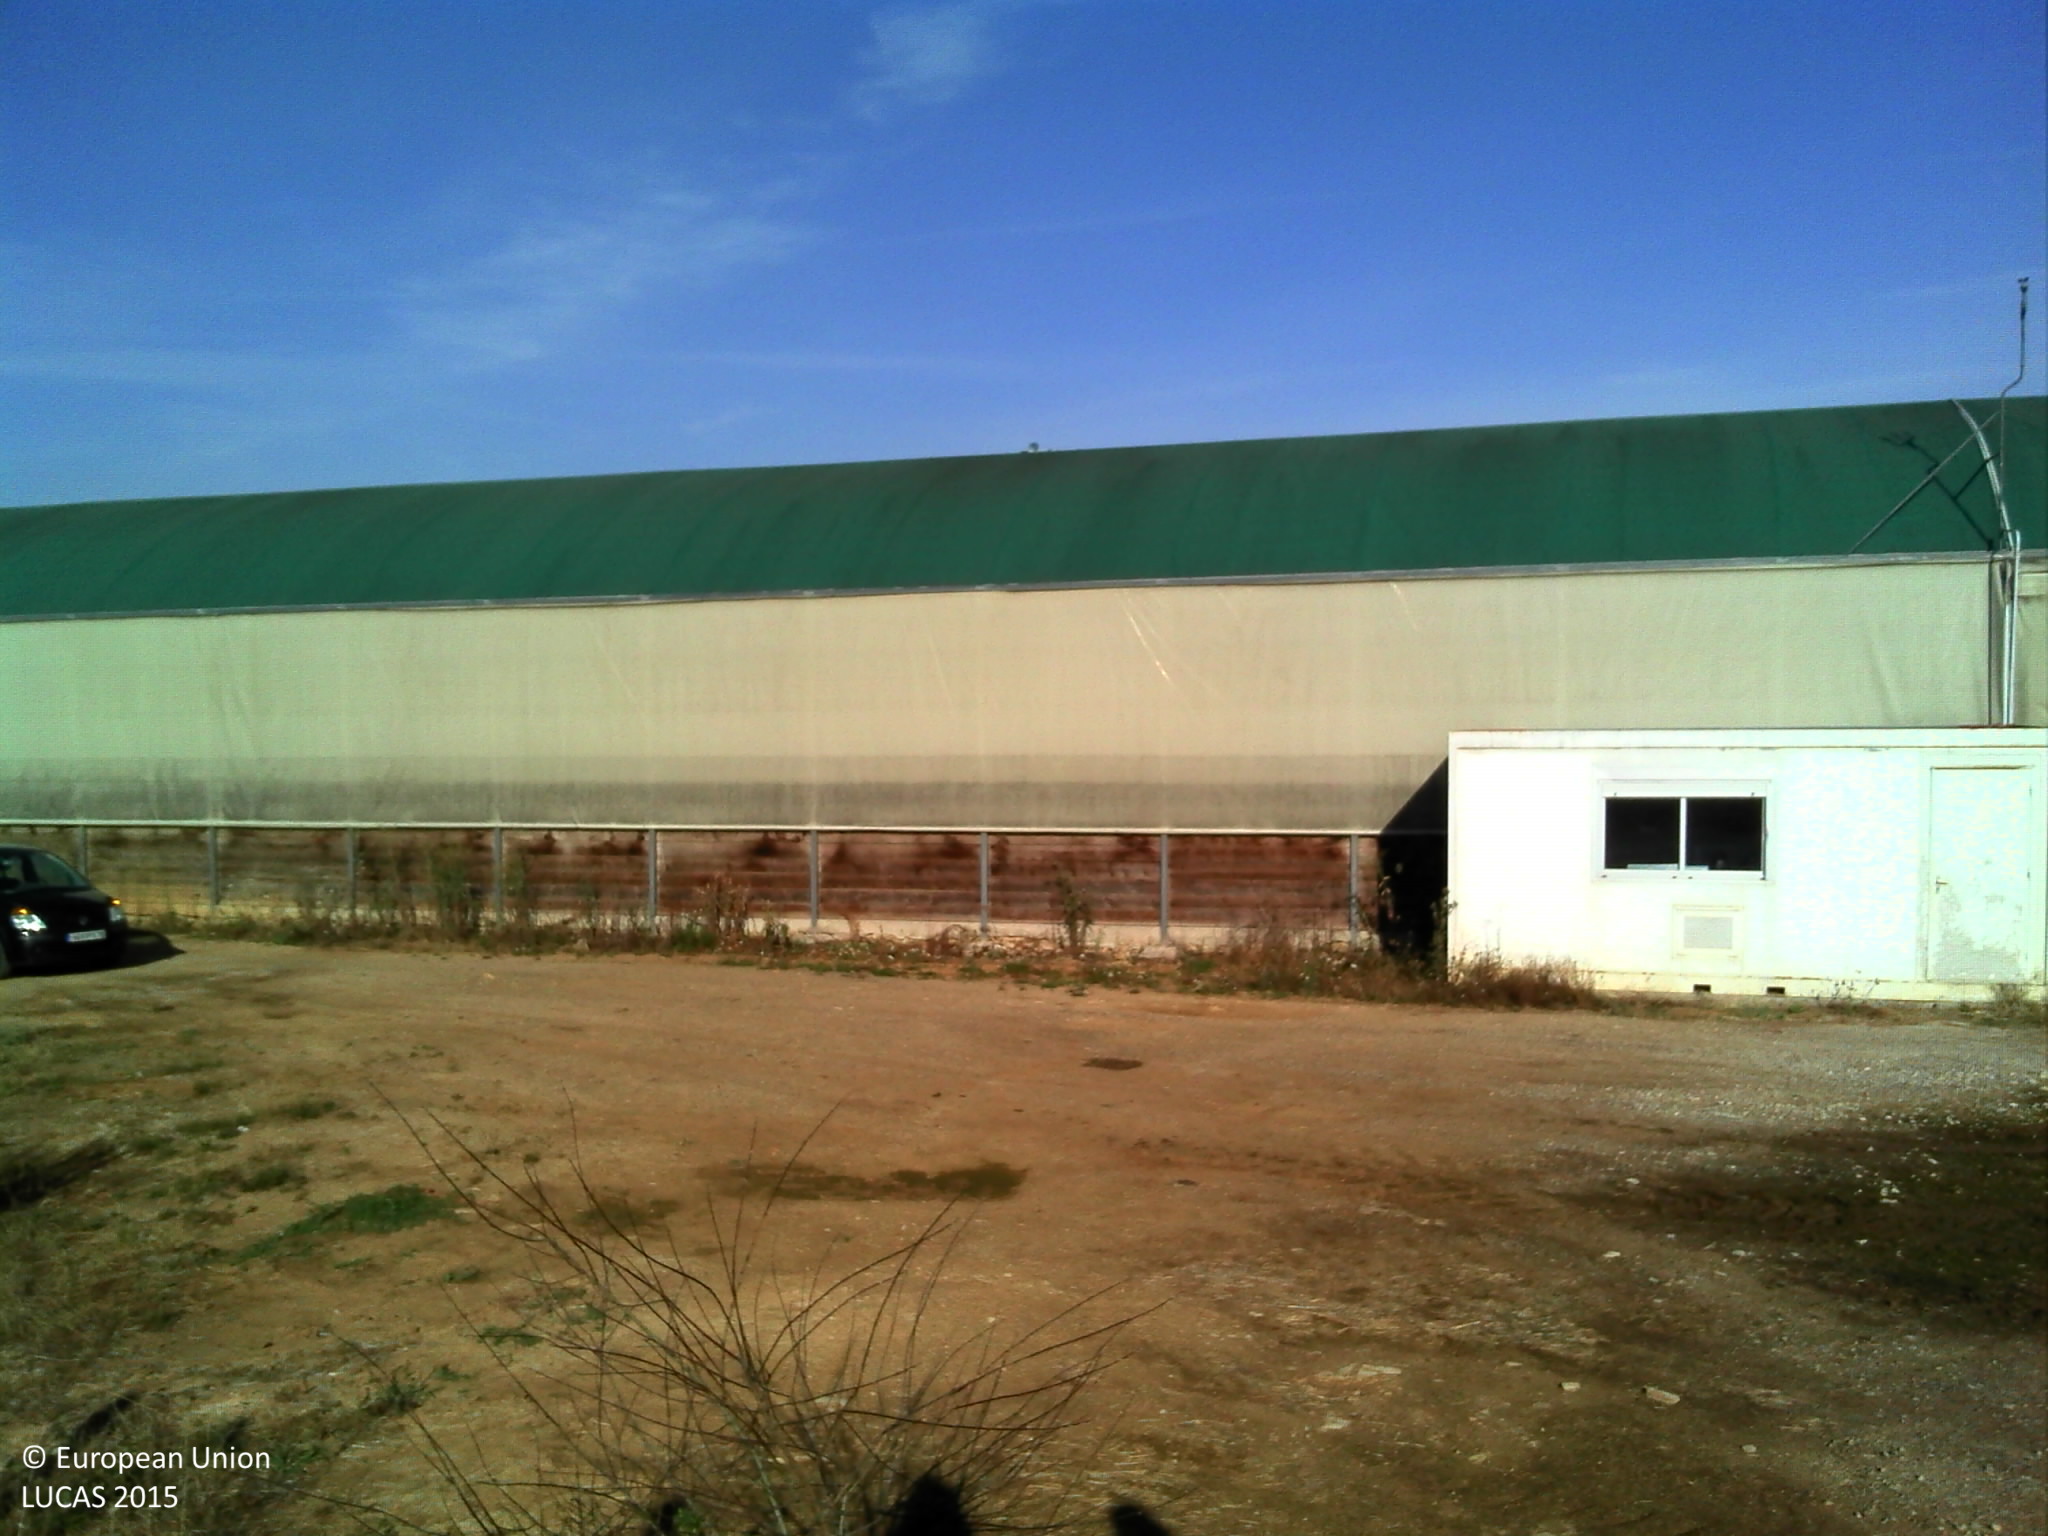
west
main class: Grassland
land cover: Grassland without tree/shrub cover
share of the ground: > 75 %
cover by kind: herbaceous plants 95 %, unconsolidated bare surface 5 %
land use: Agriculture (excluding fallow land and kitchen gardens)
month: July
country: FR
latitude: 47.6836
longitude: 5.1376
